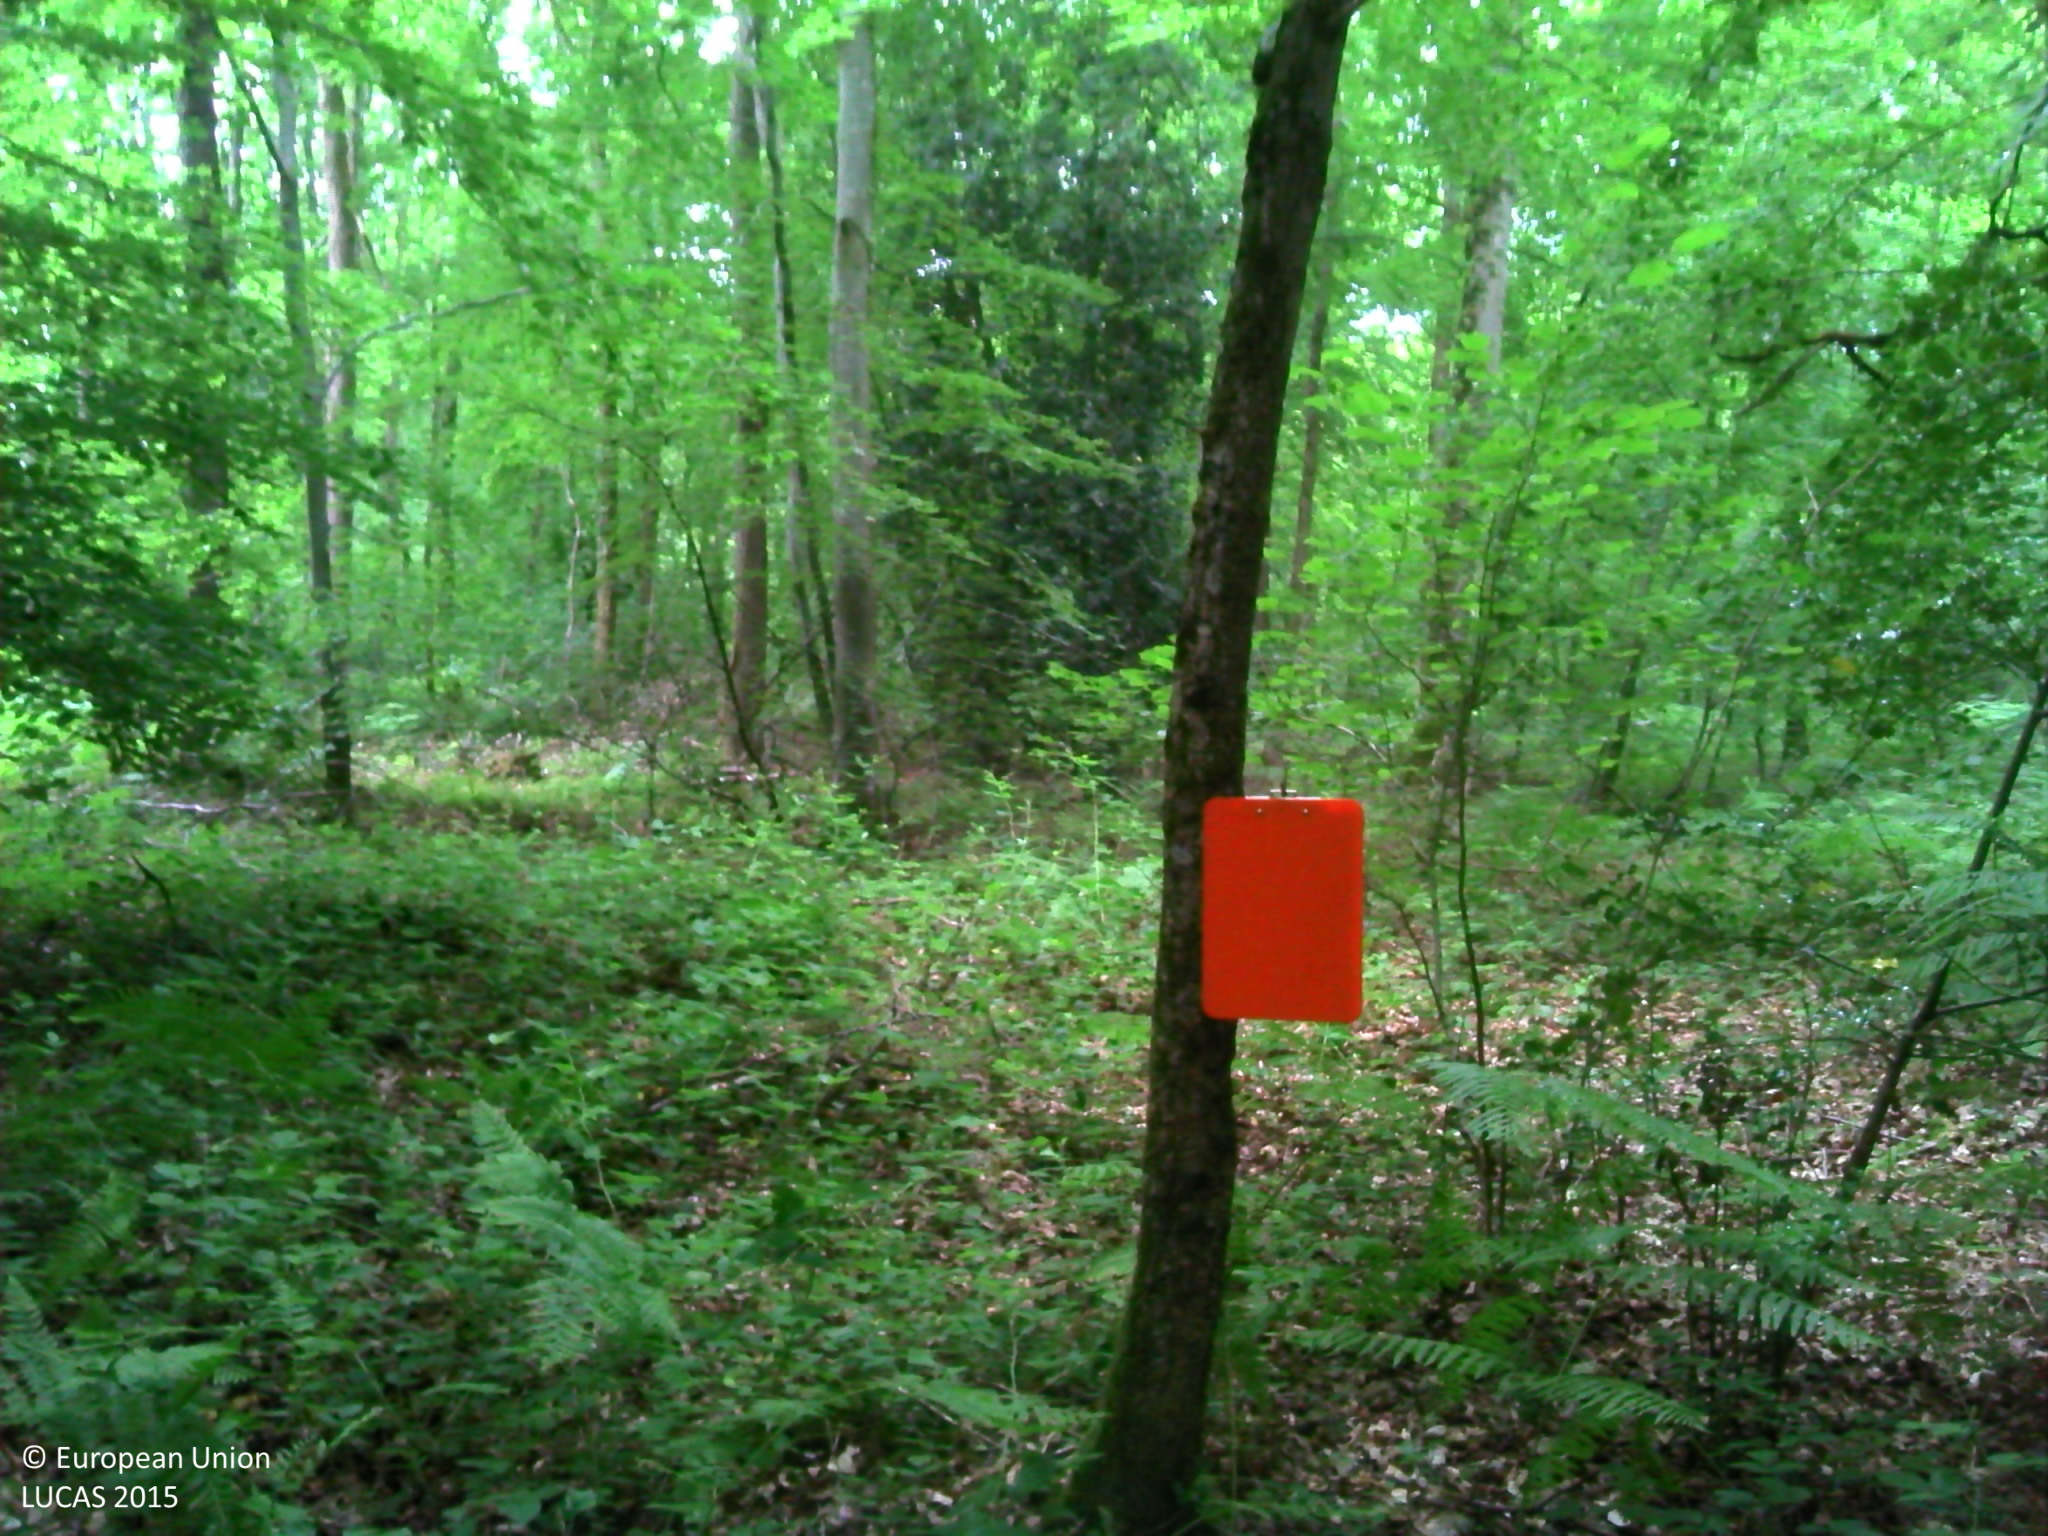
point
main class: Woodland
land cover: Broadleaved woodland
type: acidophilous oak and oak-birch forest
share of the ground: > 75 %
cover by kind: broadleaved forest trees 75 %, coniferous forest trees 10 %, herbaceous plants 10 %, shrubs 5 %
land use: Forestry
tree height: > 5 m
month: July
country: FR
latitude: 48.9345
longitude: 0.0732
